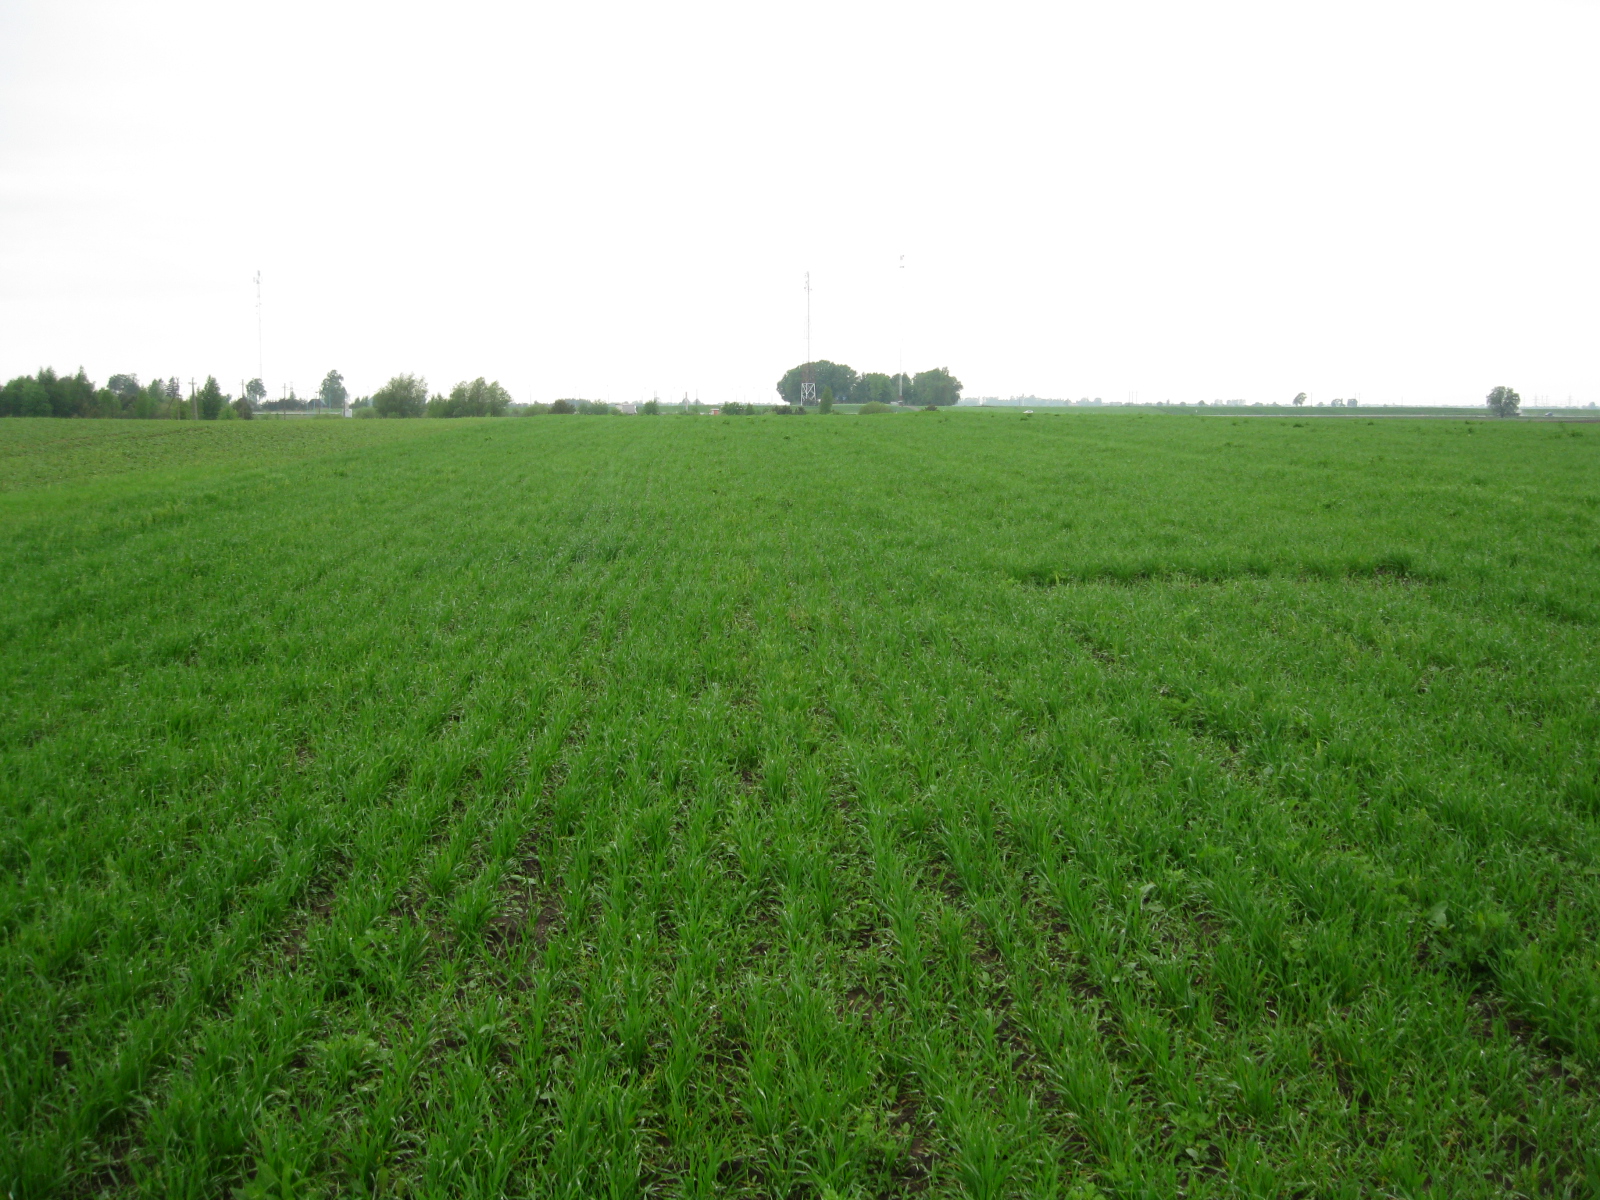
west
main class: Cropland
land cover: Common wheat
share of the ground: > 75 %
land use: Agriculture (excluding fallow land and kitchen gardens)
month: May
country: LT
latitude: 55.9062
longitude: 24.3475
